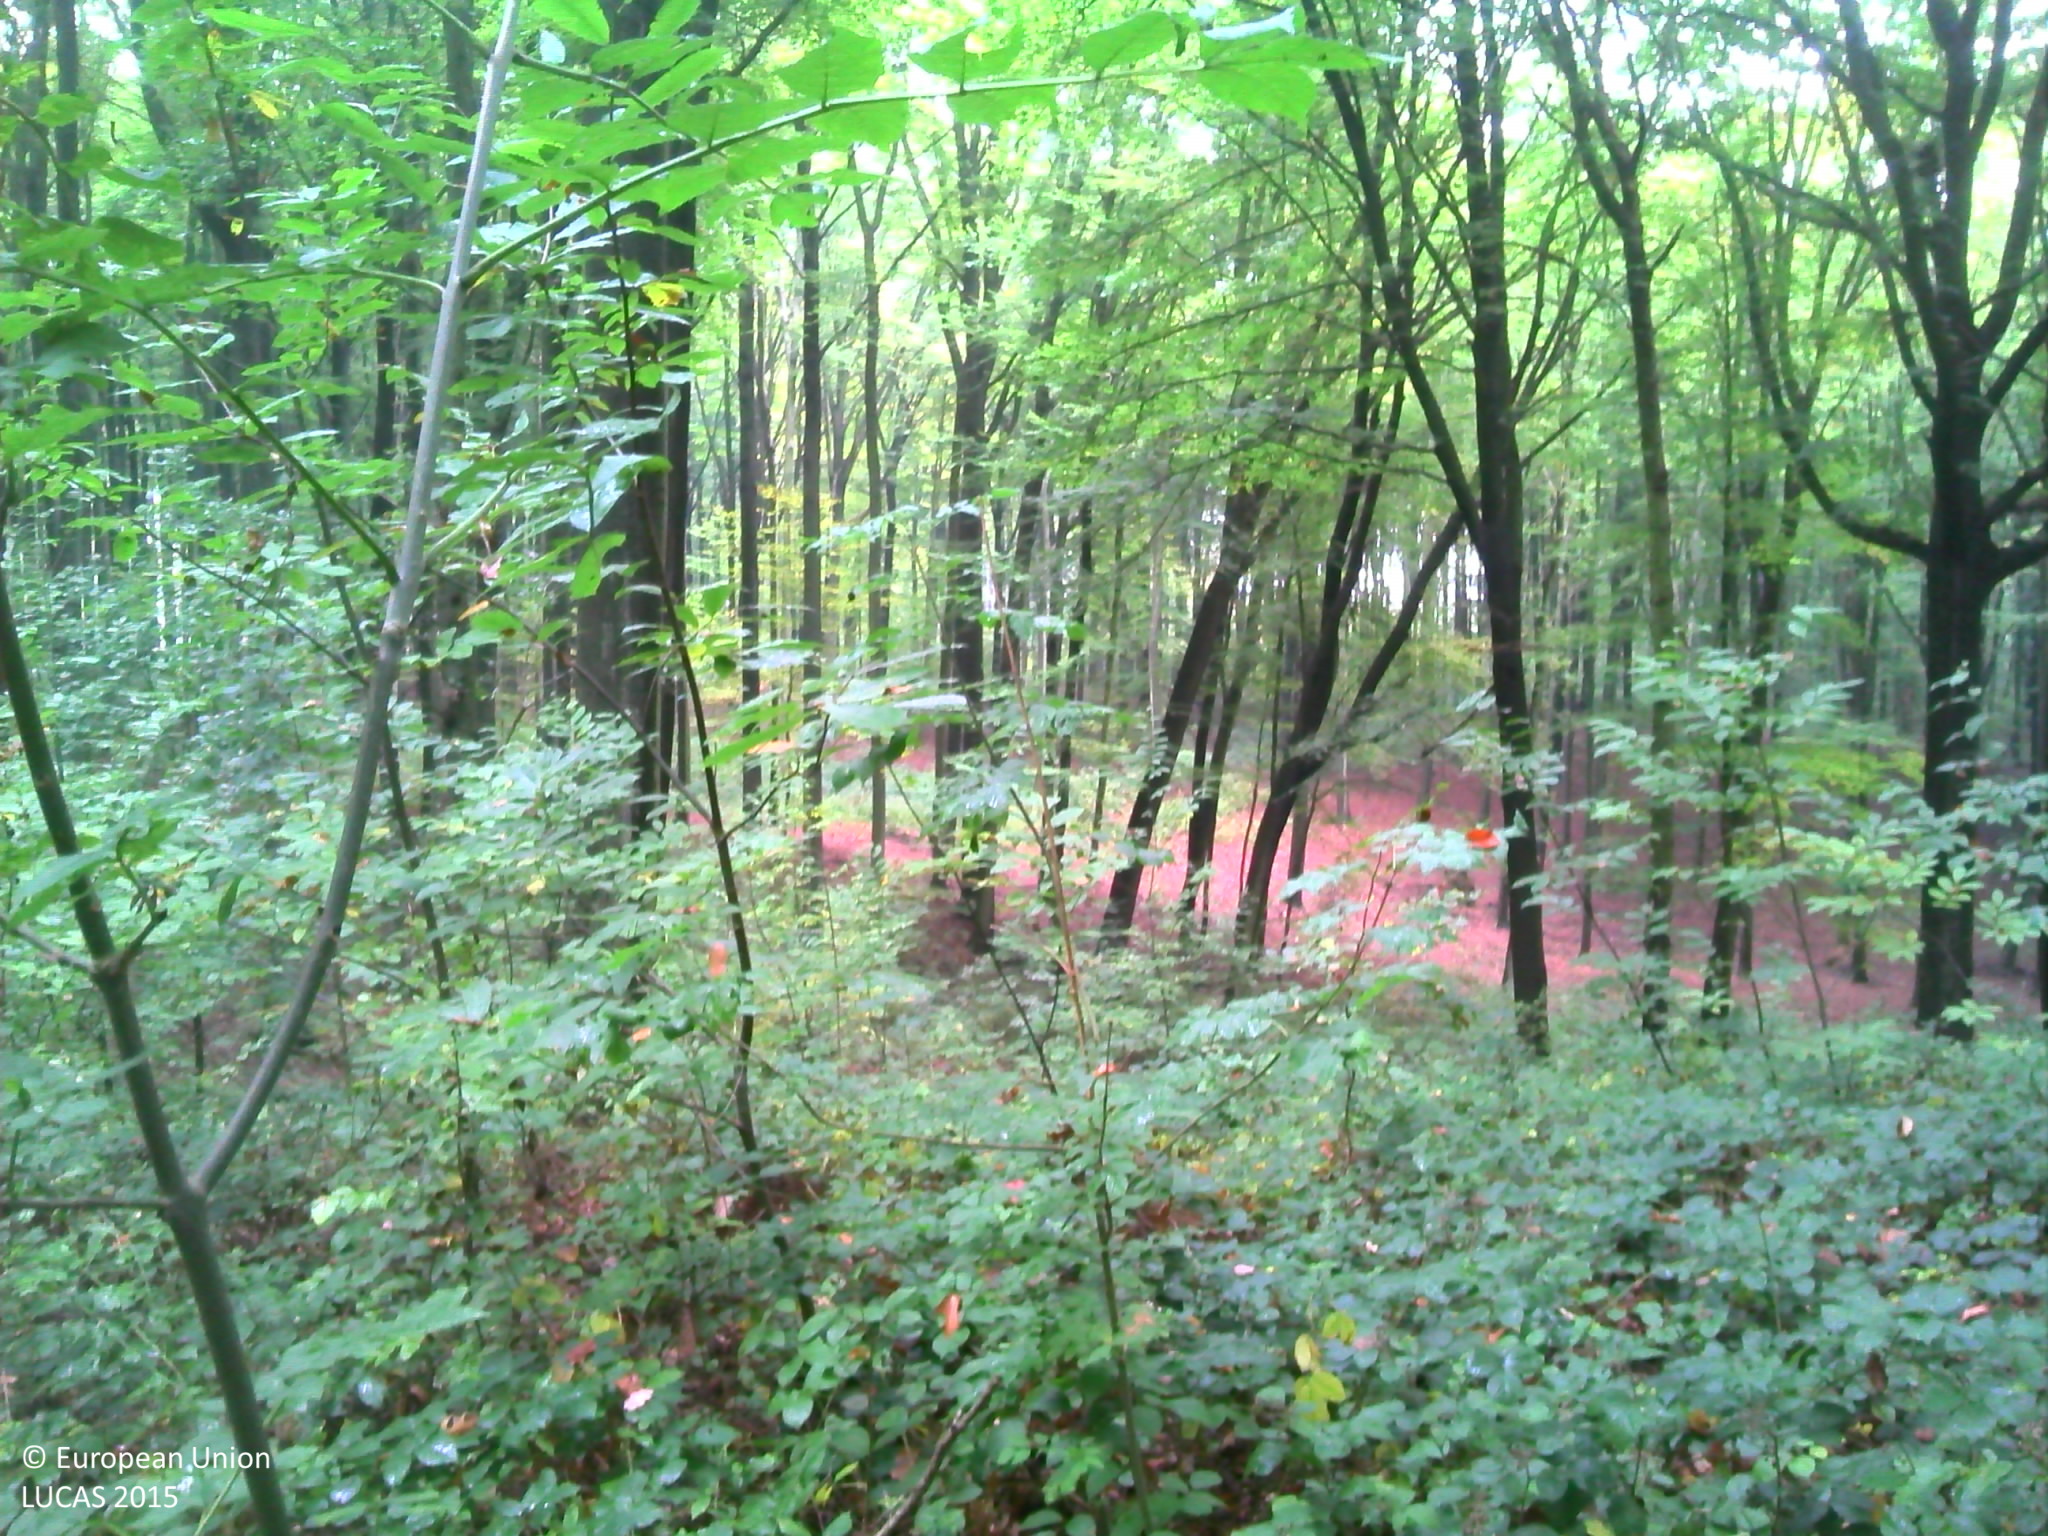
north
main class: Woodland
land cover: Broadleaved woodland
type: beech forest
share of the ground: > 75 %
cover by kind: broadleaved forest trees 80 %, shrubs 10 %, herbaceous plants 10 %
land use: Forestry
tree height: > 5 m
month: October
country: BE
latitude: 50.8651
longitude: 4.5541
